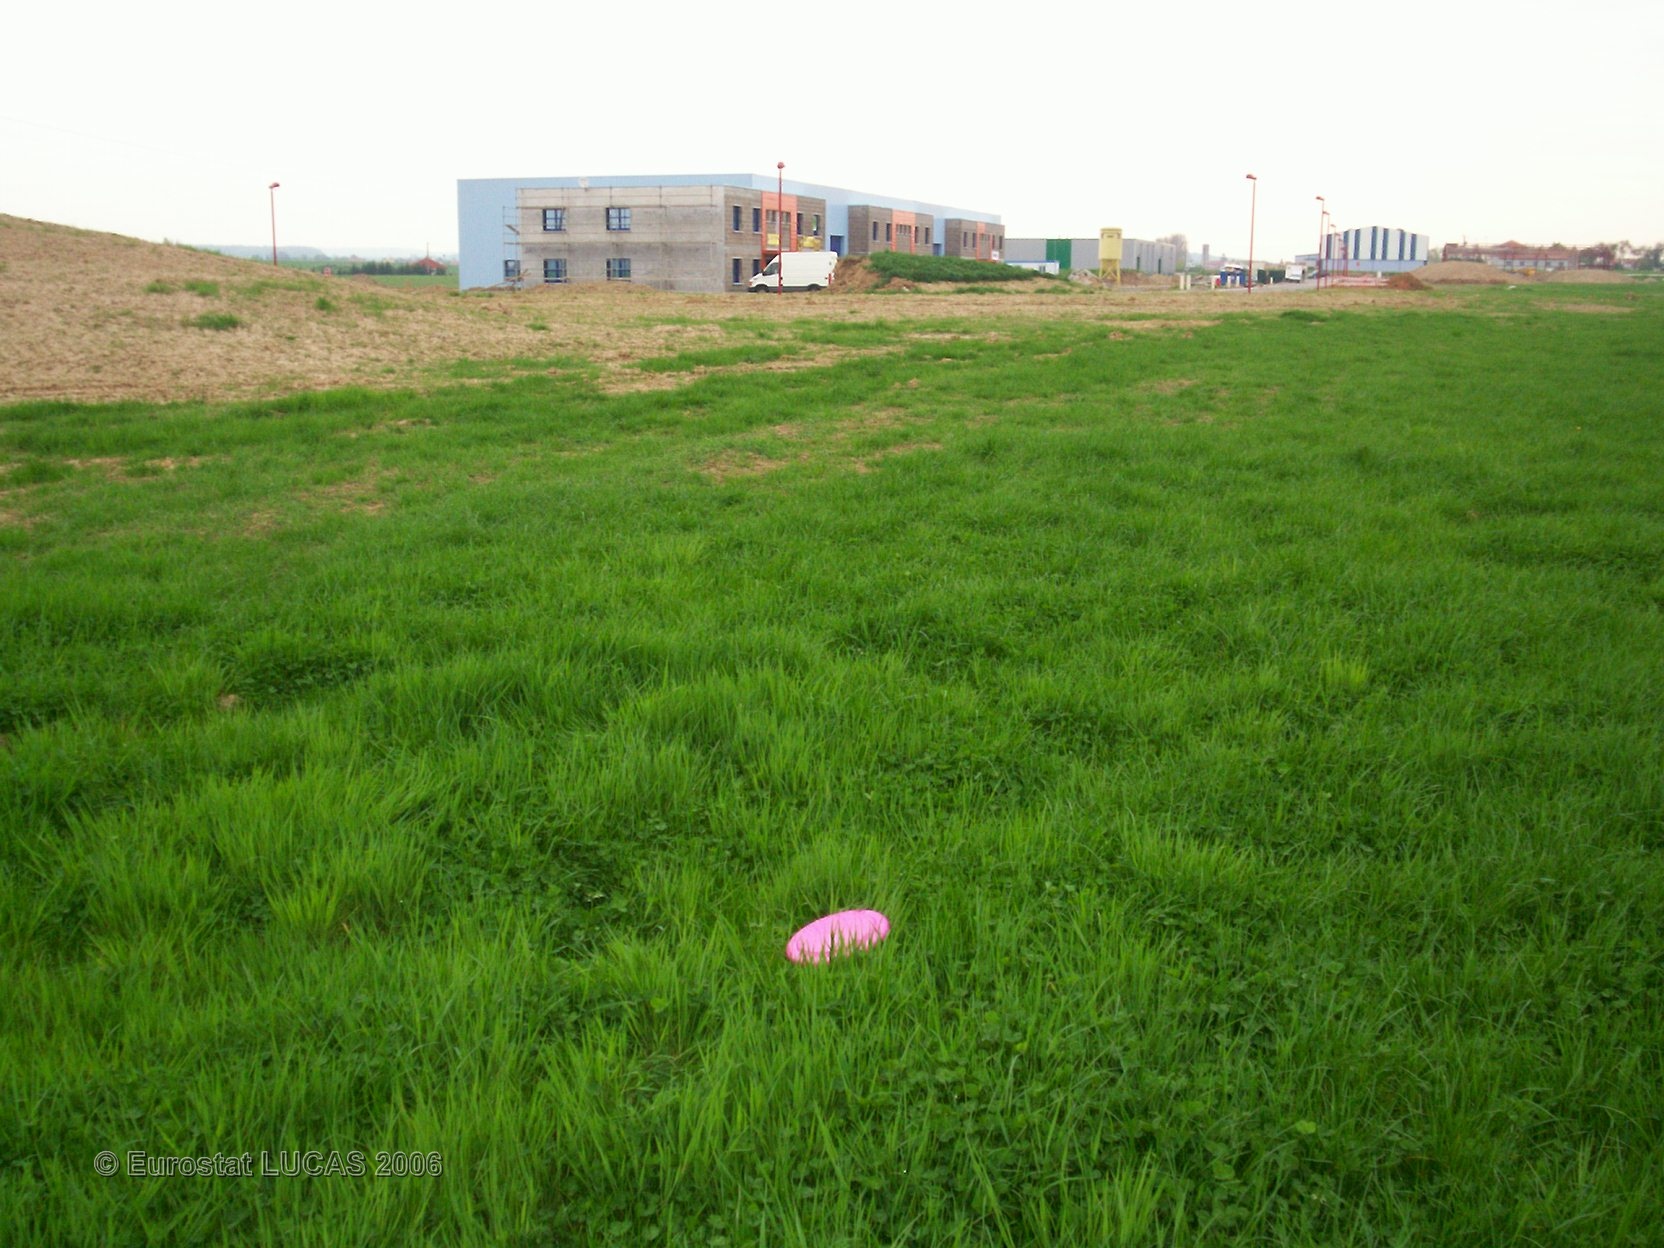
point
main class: Grassland
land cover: Grassland without tree/shrub cover
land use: Agriculture (excluding fallow land and kitchen gardens)
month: April
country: FR
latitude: 48.9511
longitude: 6.7913
